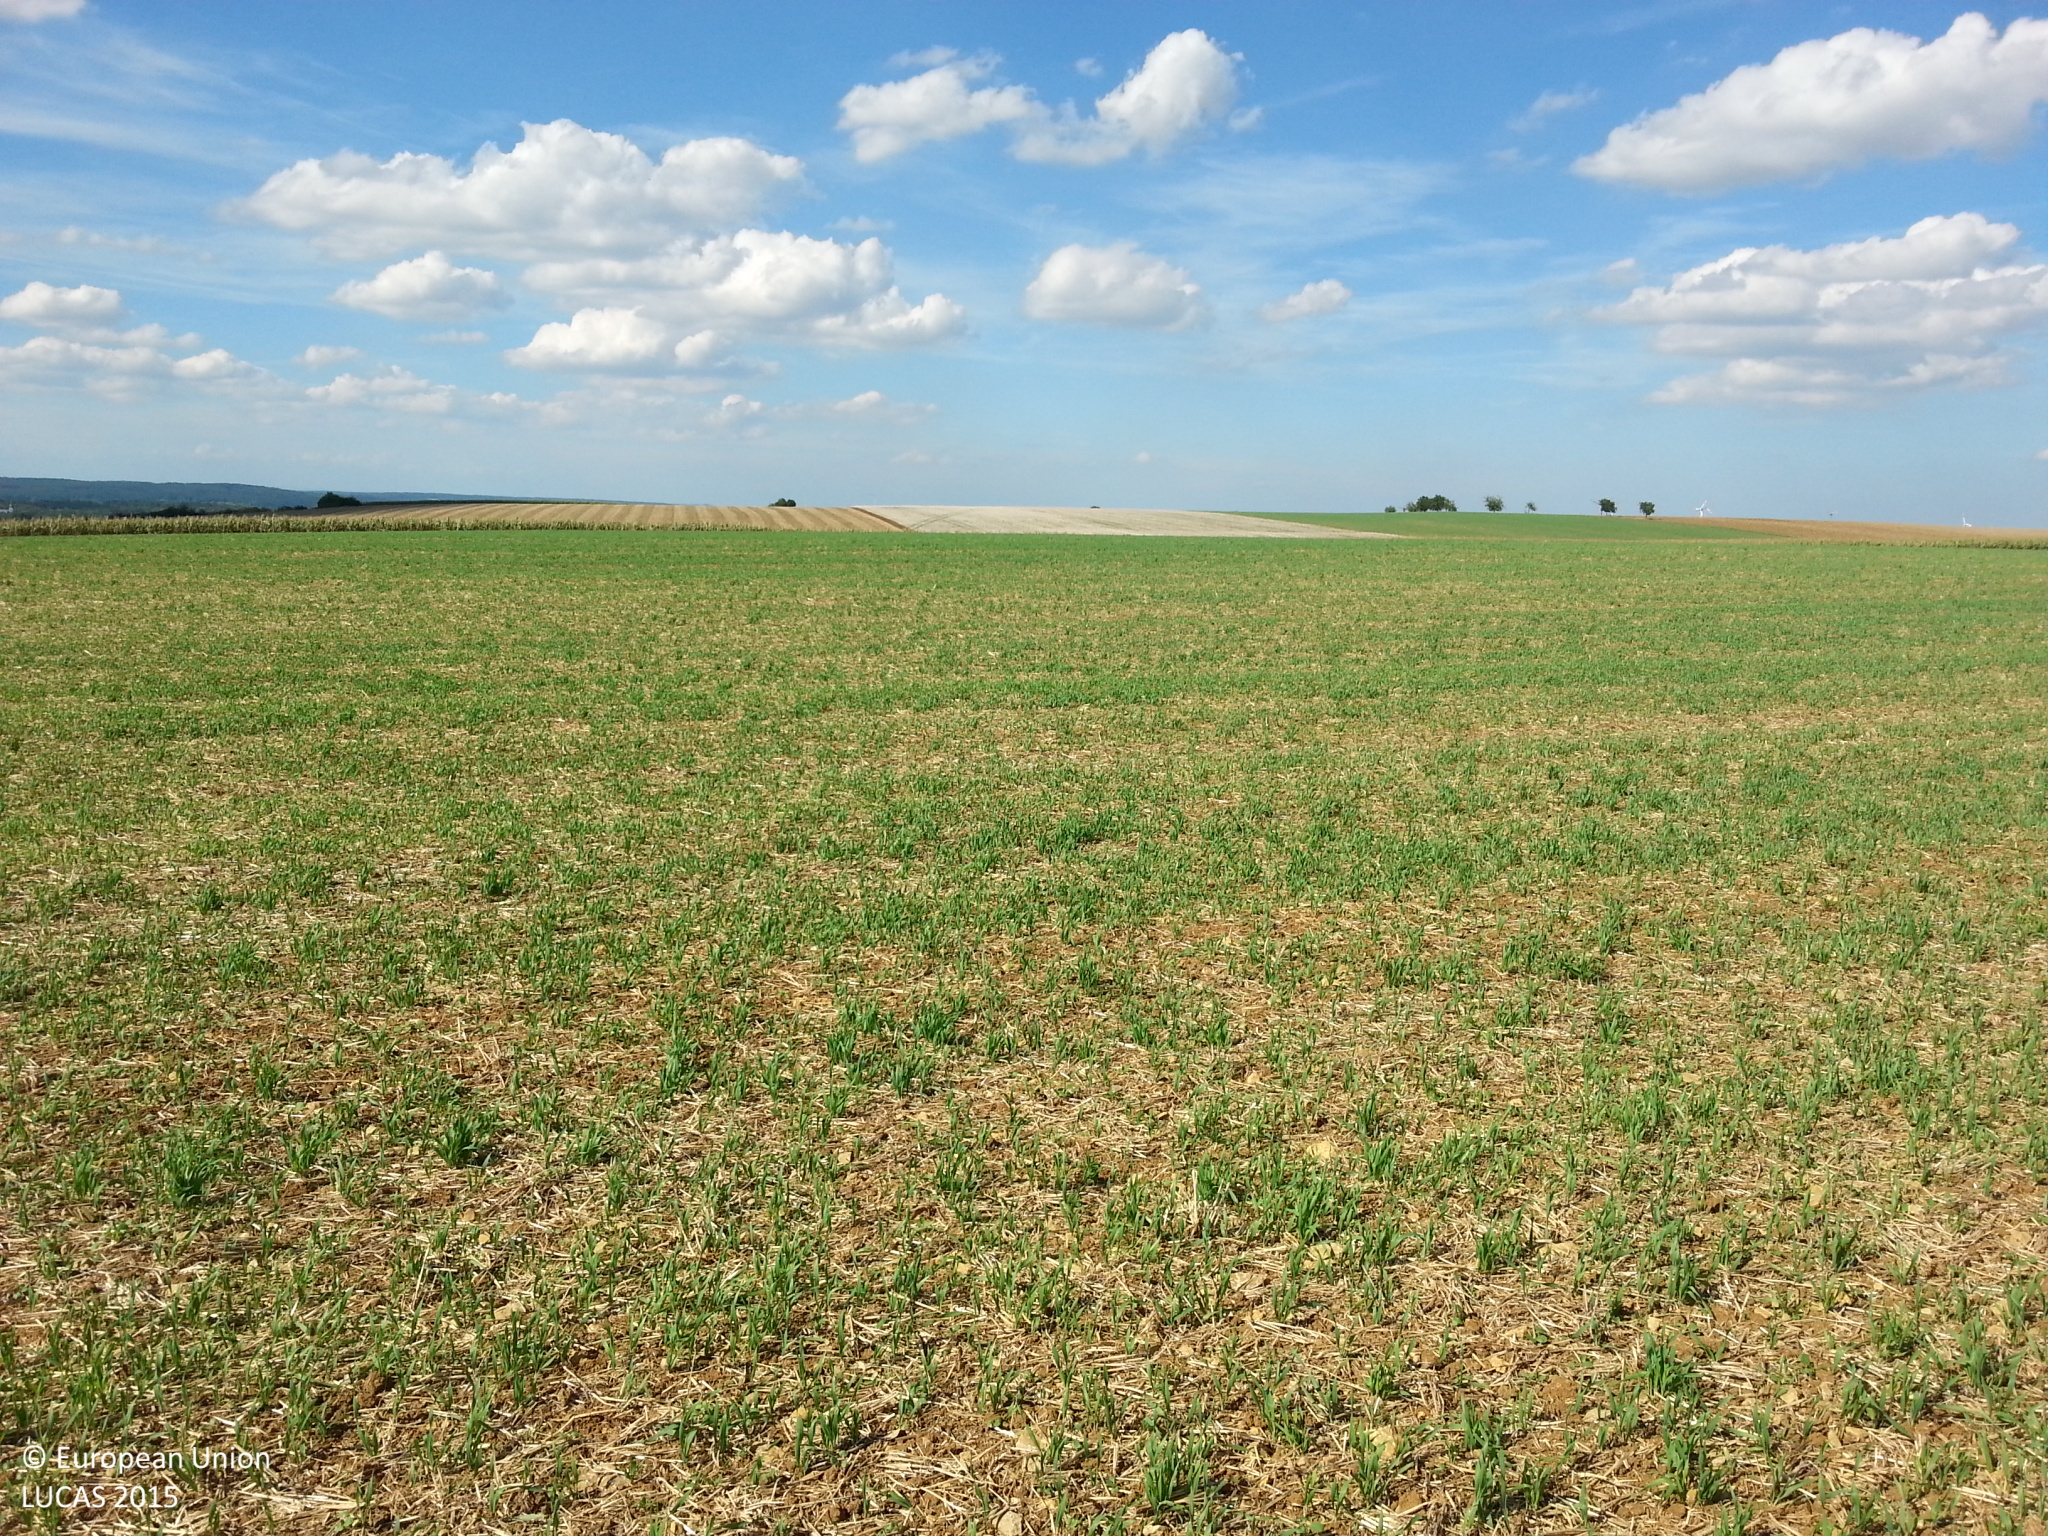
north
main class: Cropland
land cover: Temporary grasslands
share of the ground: 50 - 75 %
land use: Agriculture (excluding fallow land and kitchen gardens)
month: August
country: DE
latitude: 49.4289
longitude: 9.9587
